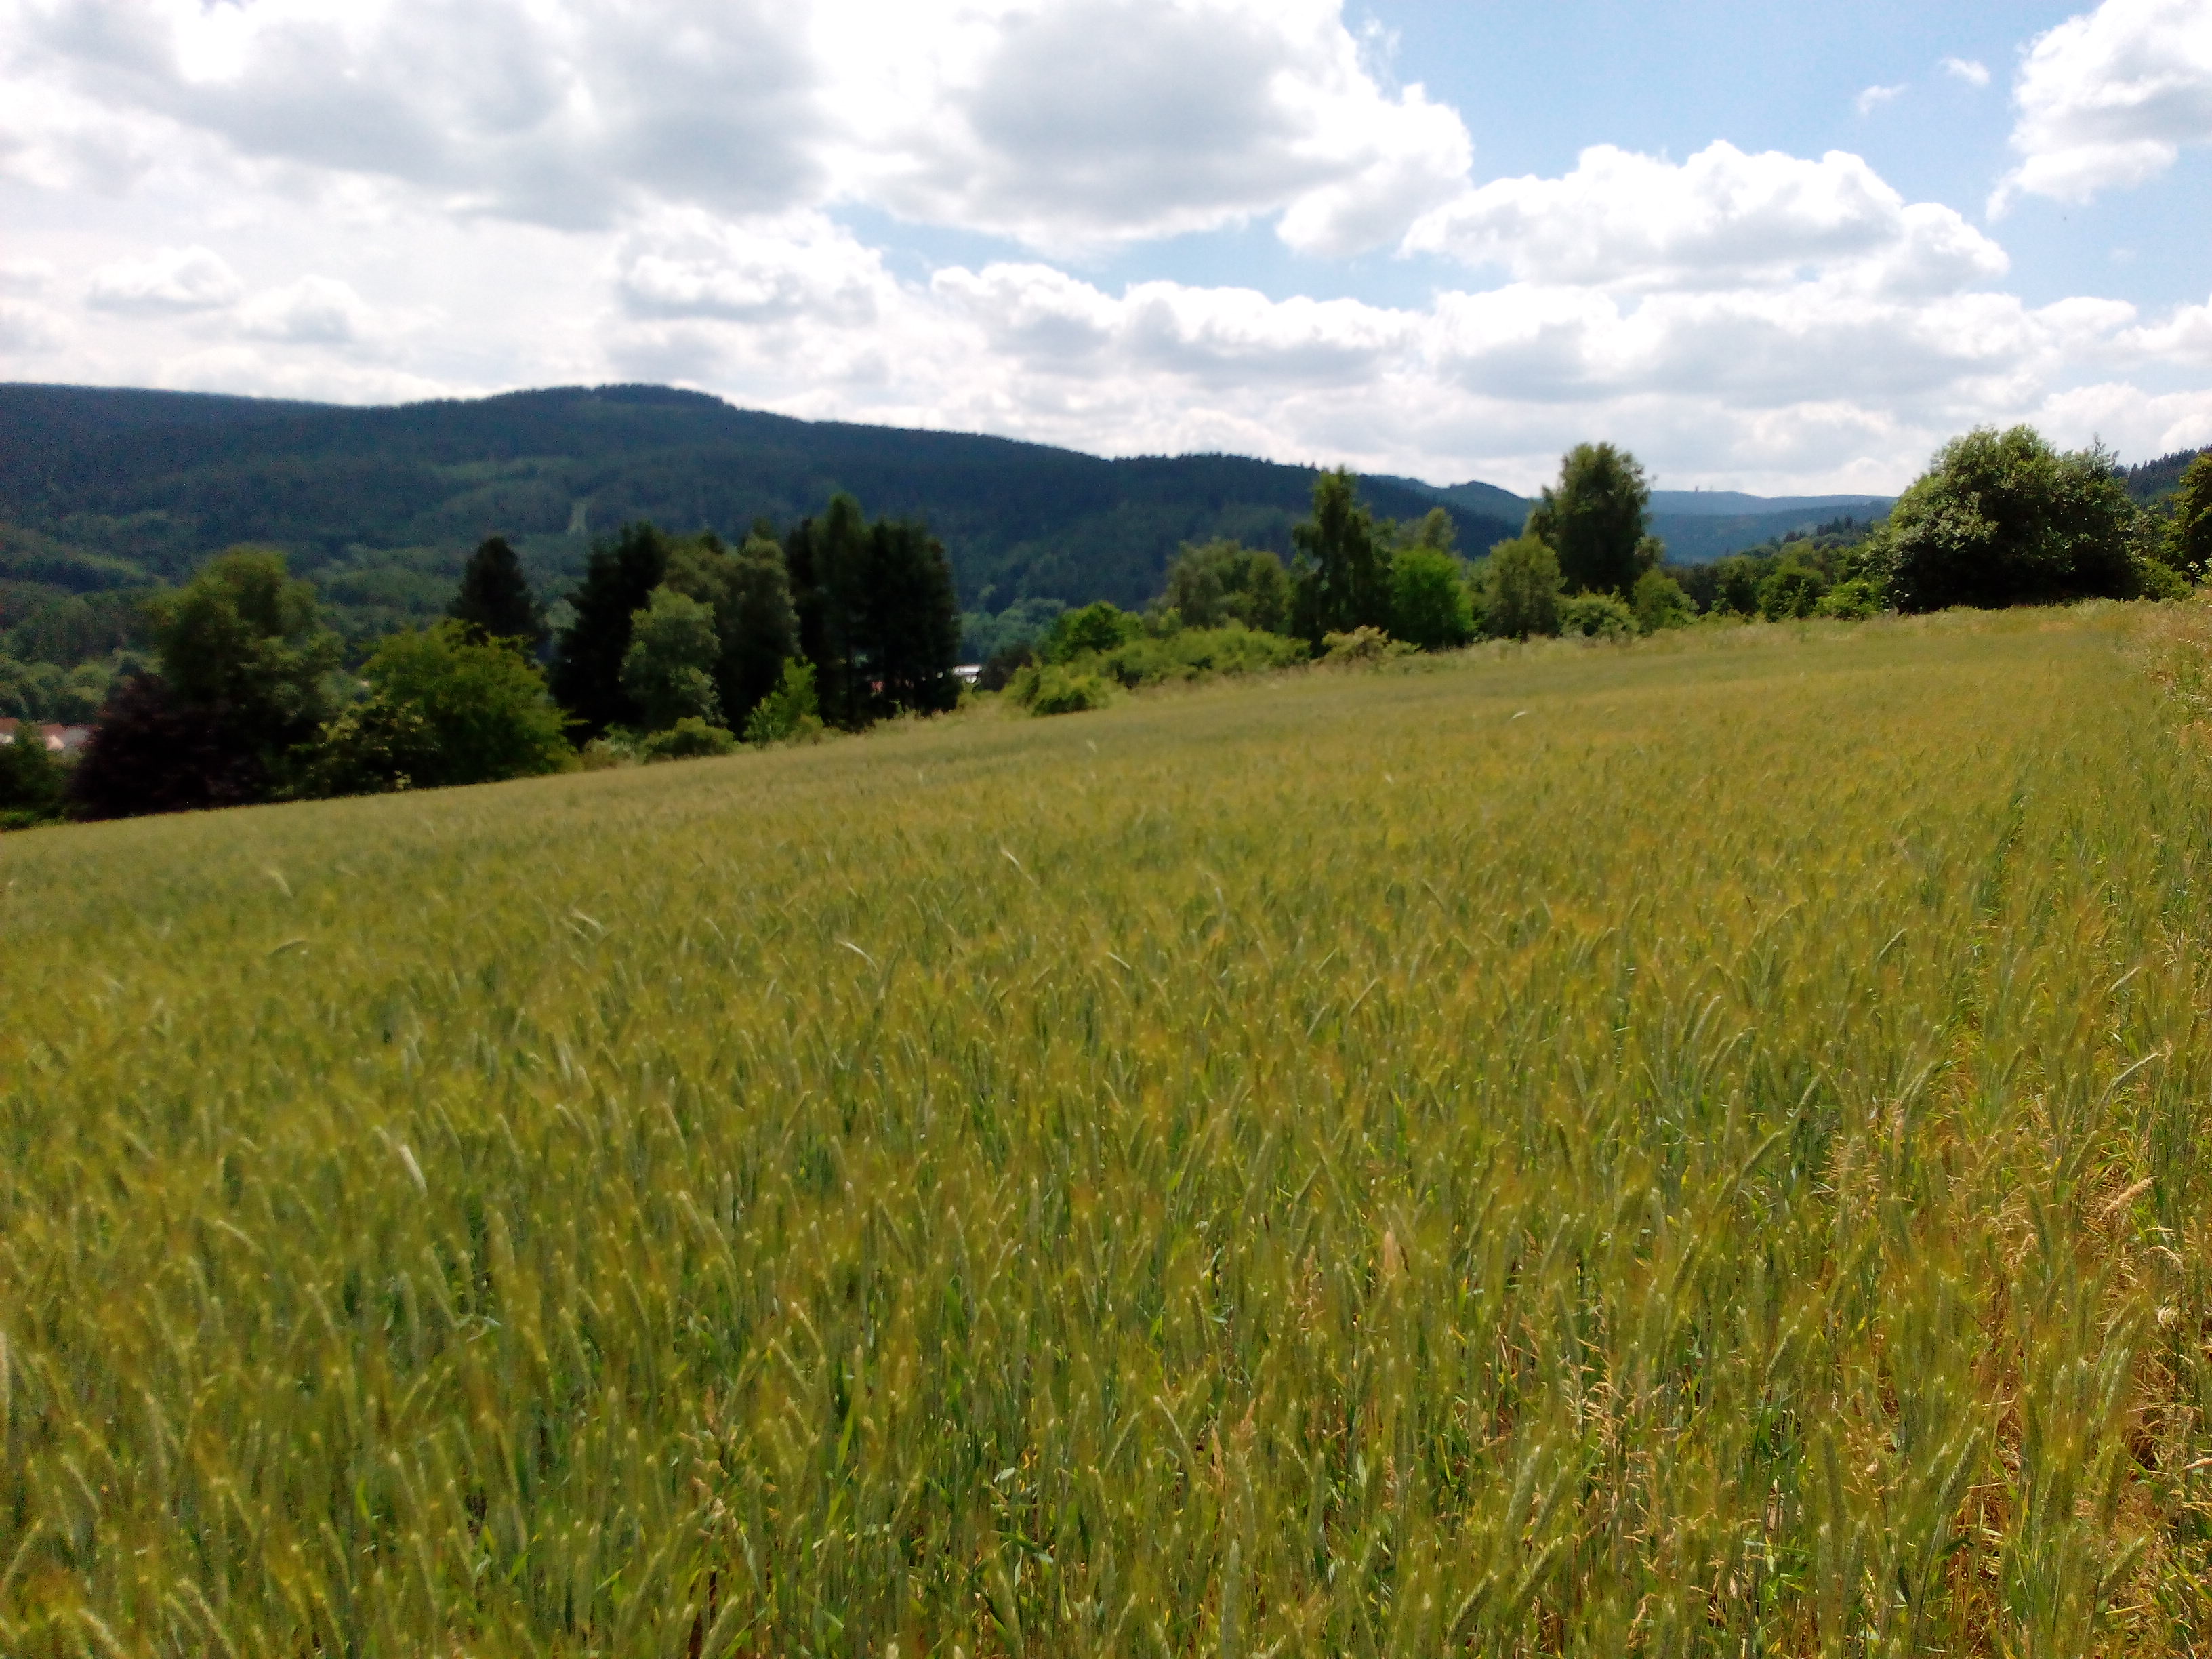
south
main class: Cropland
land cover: Triticale
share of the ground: > 75 %
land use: Agriculture (excluding fallow land and kitchen gardens)
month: June
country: DE
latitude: 50.7206
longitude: 10.8355
